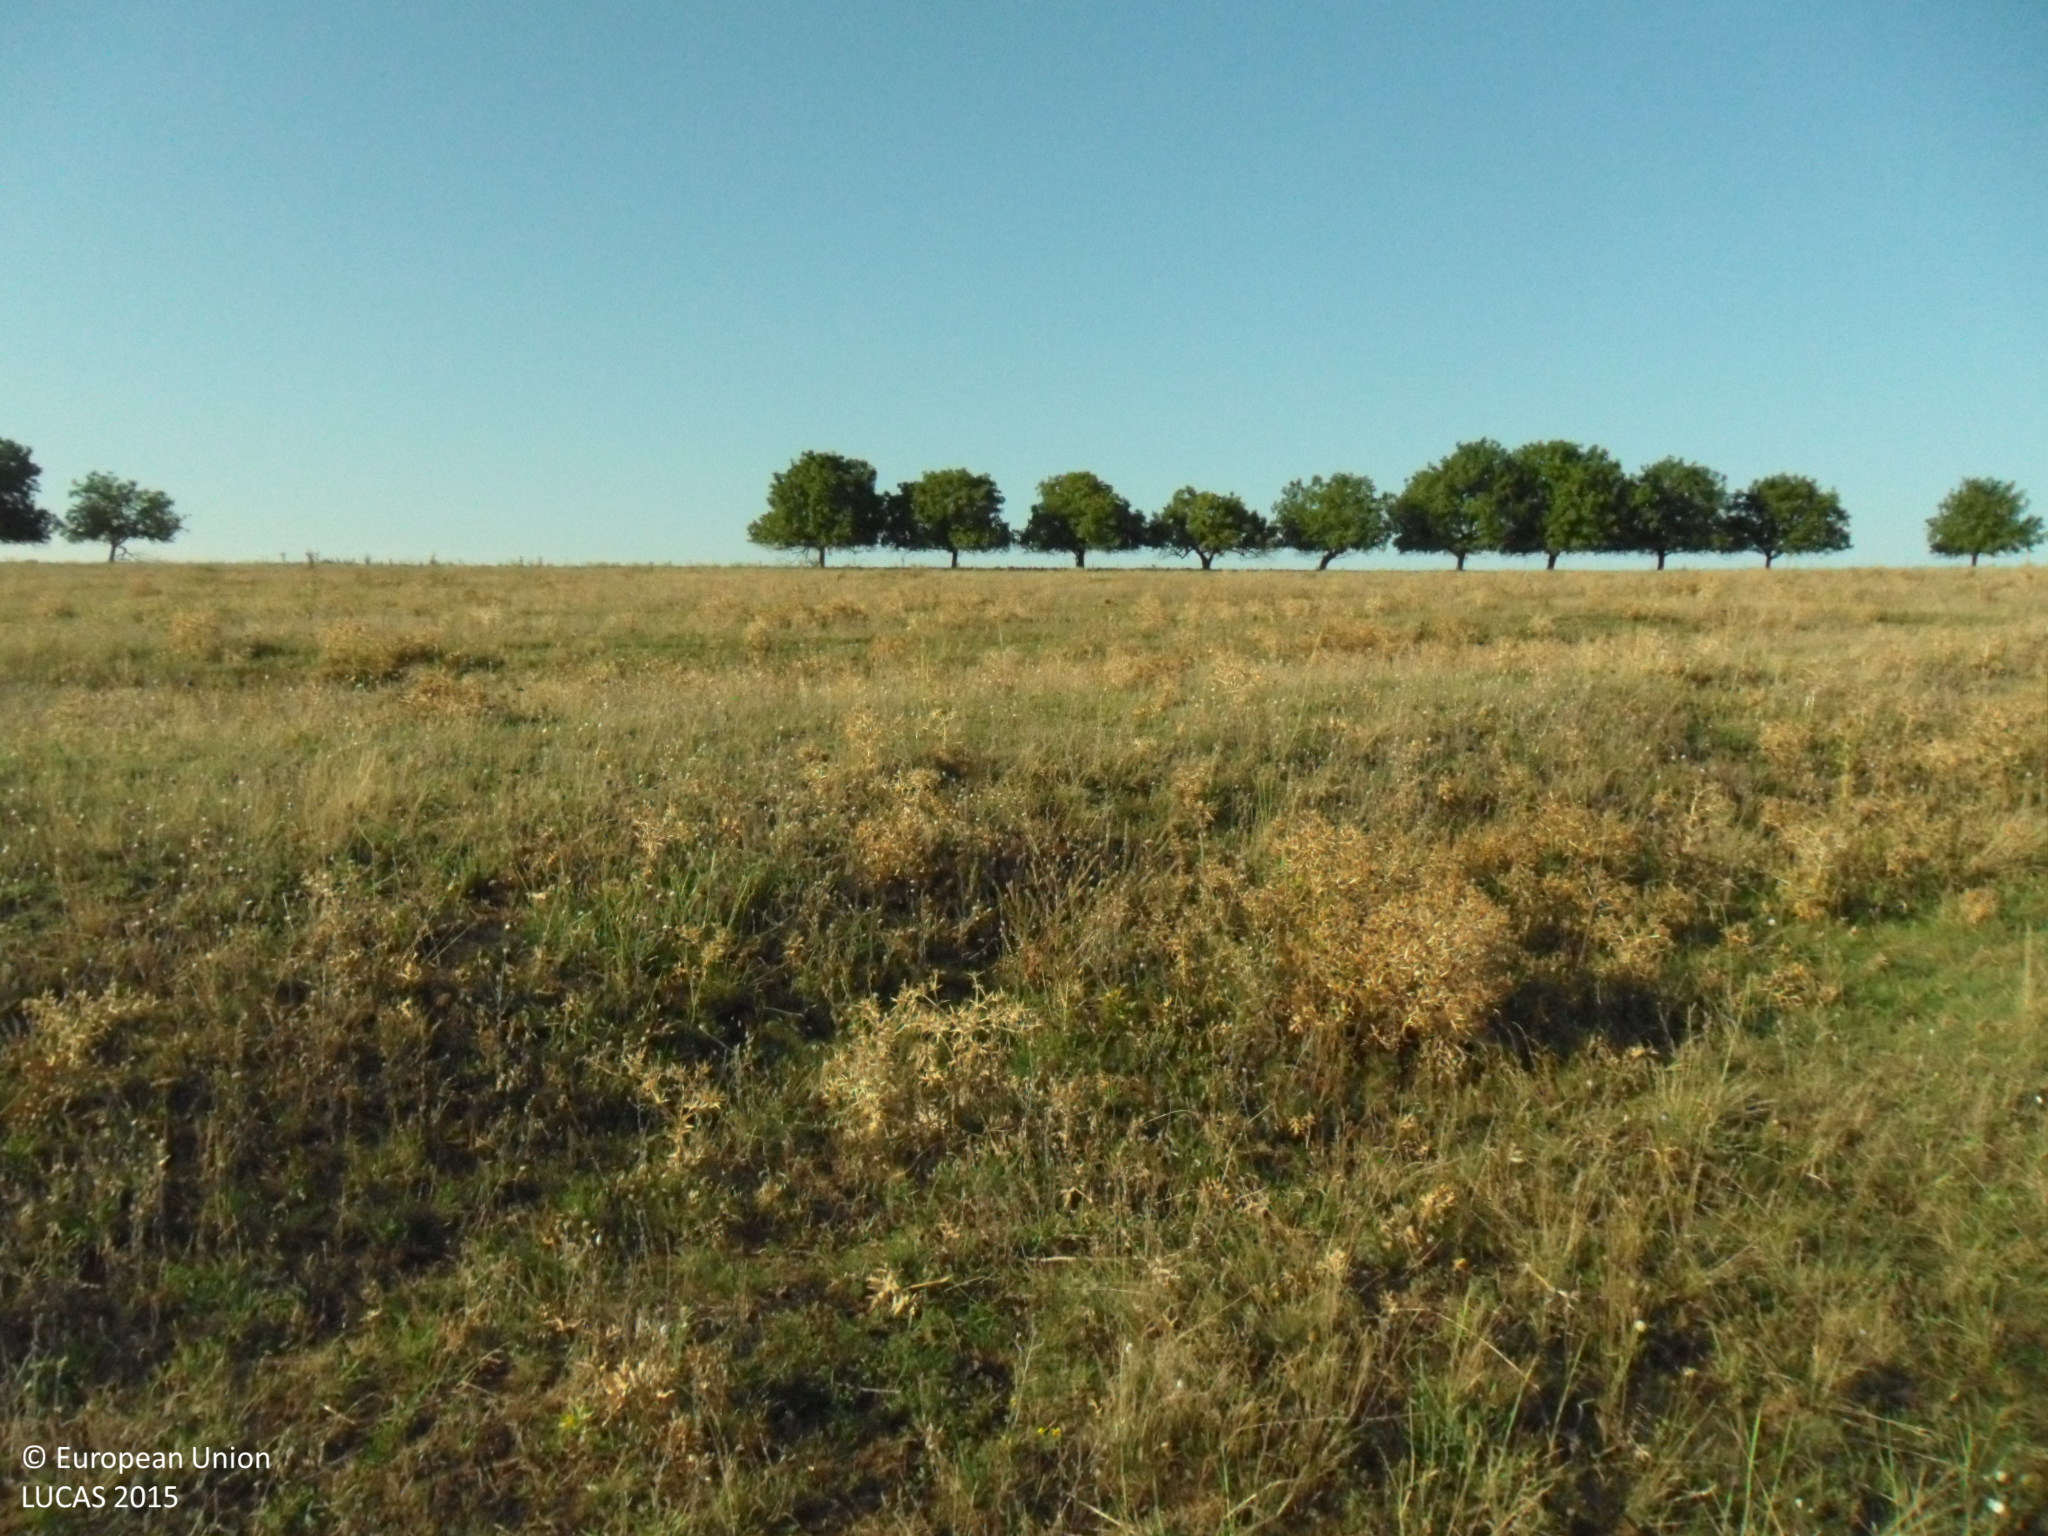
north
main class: Grassland
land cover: Grassland without tree/shrub cover
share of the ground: > 75 %
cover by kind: herbaceous plants 100 %
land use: Agriculture (excluding fallow land and kitchen gardens)
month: September
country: BG
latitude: 43.4513
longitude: 27.2130
